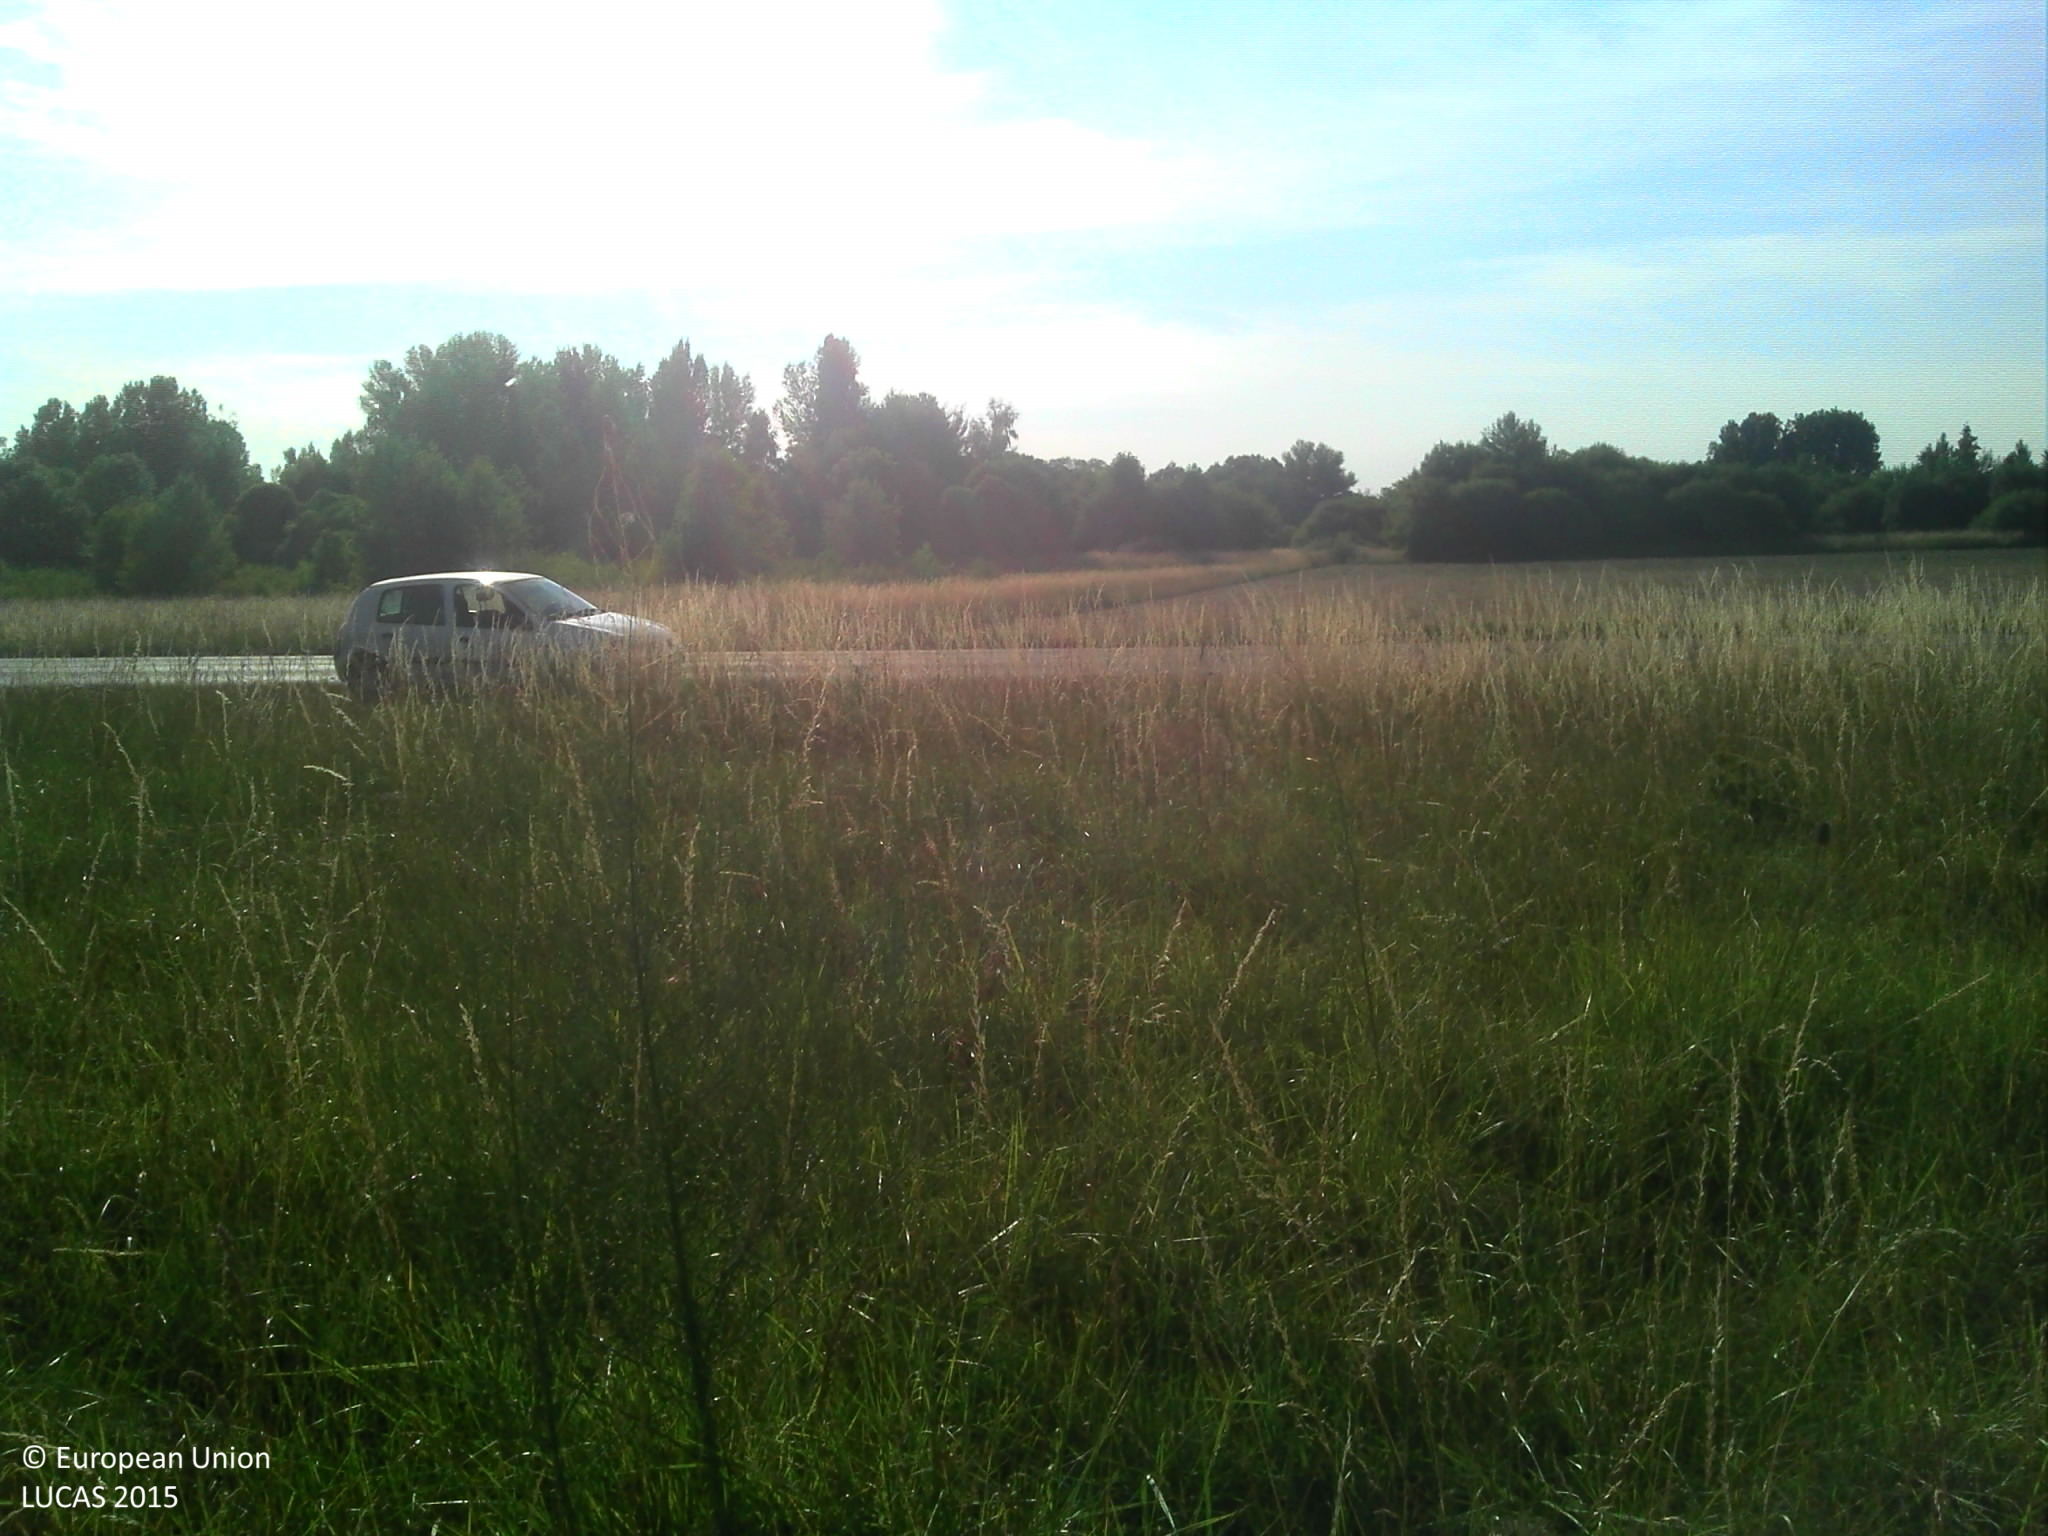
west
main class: Grassland
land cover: Grassland with sparse tree/shrub cover
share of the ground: > 75 %
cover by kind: herbaceous plants 95 %, broadleaved forest trees 5 %
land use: Construction
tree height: > 5 m
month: June
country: FR
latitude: 47.3994
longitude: 1.4132
